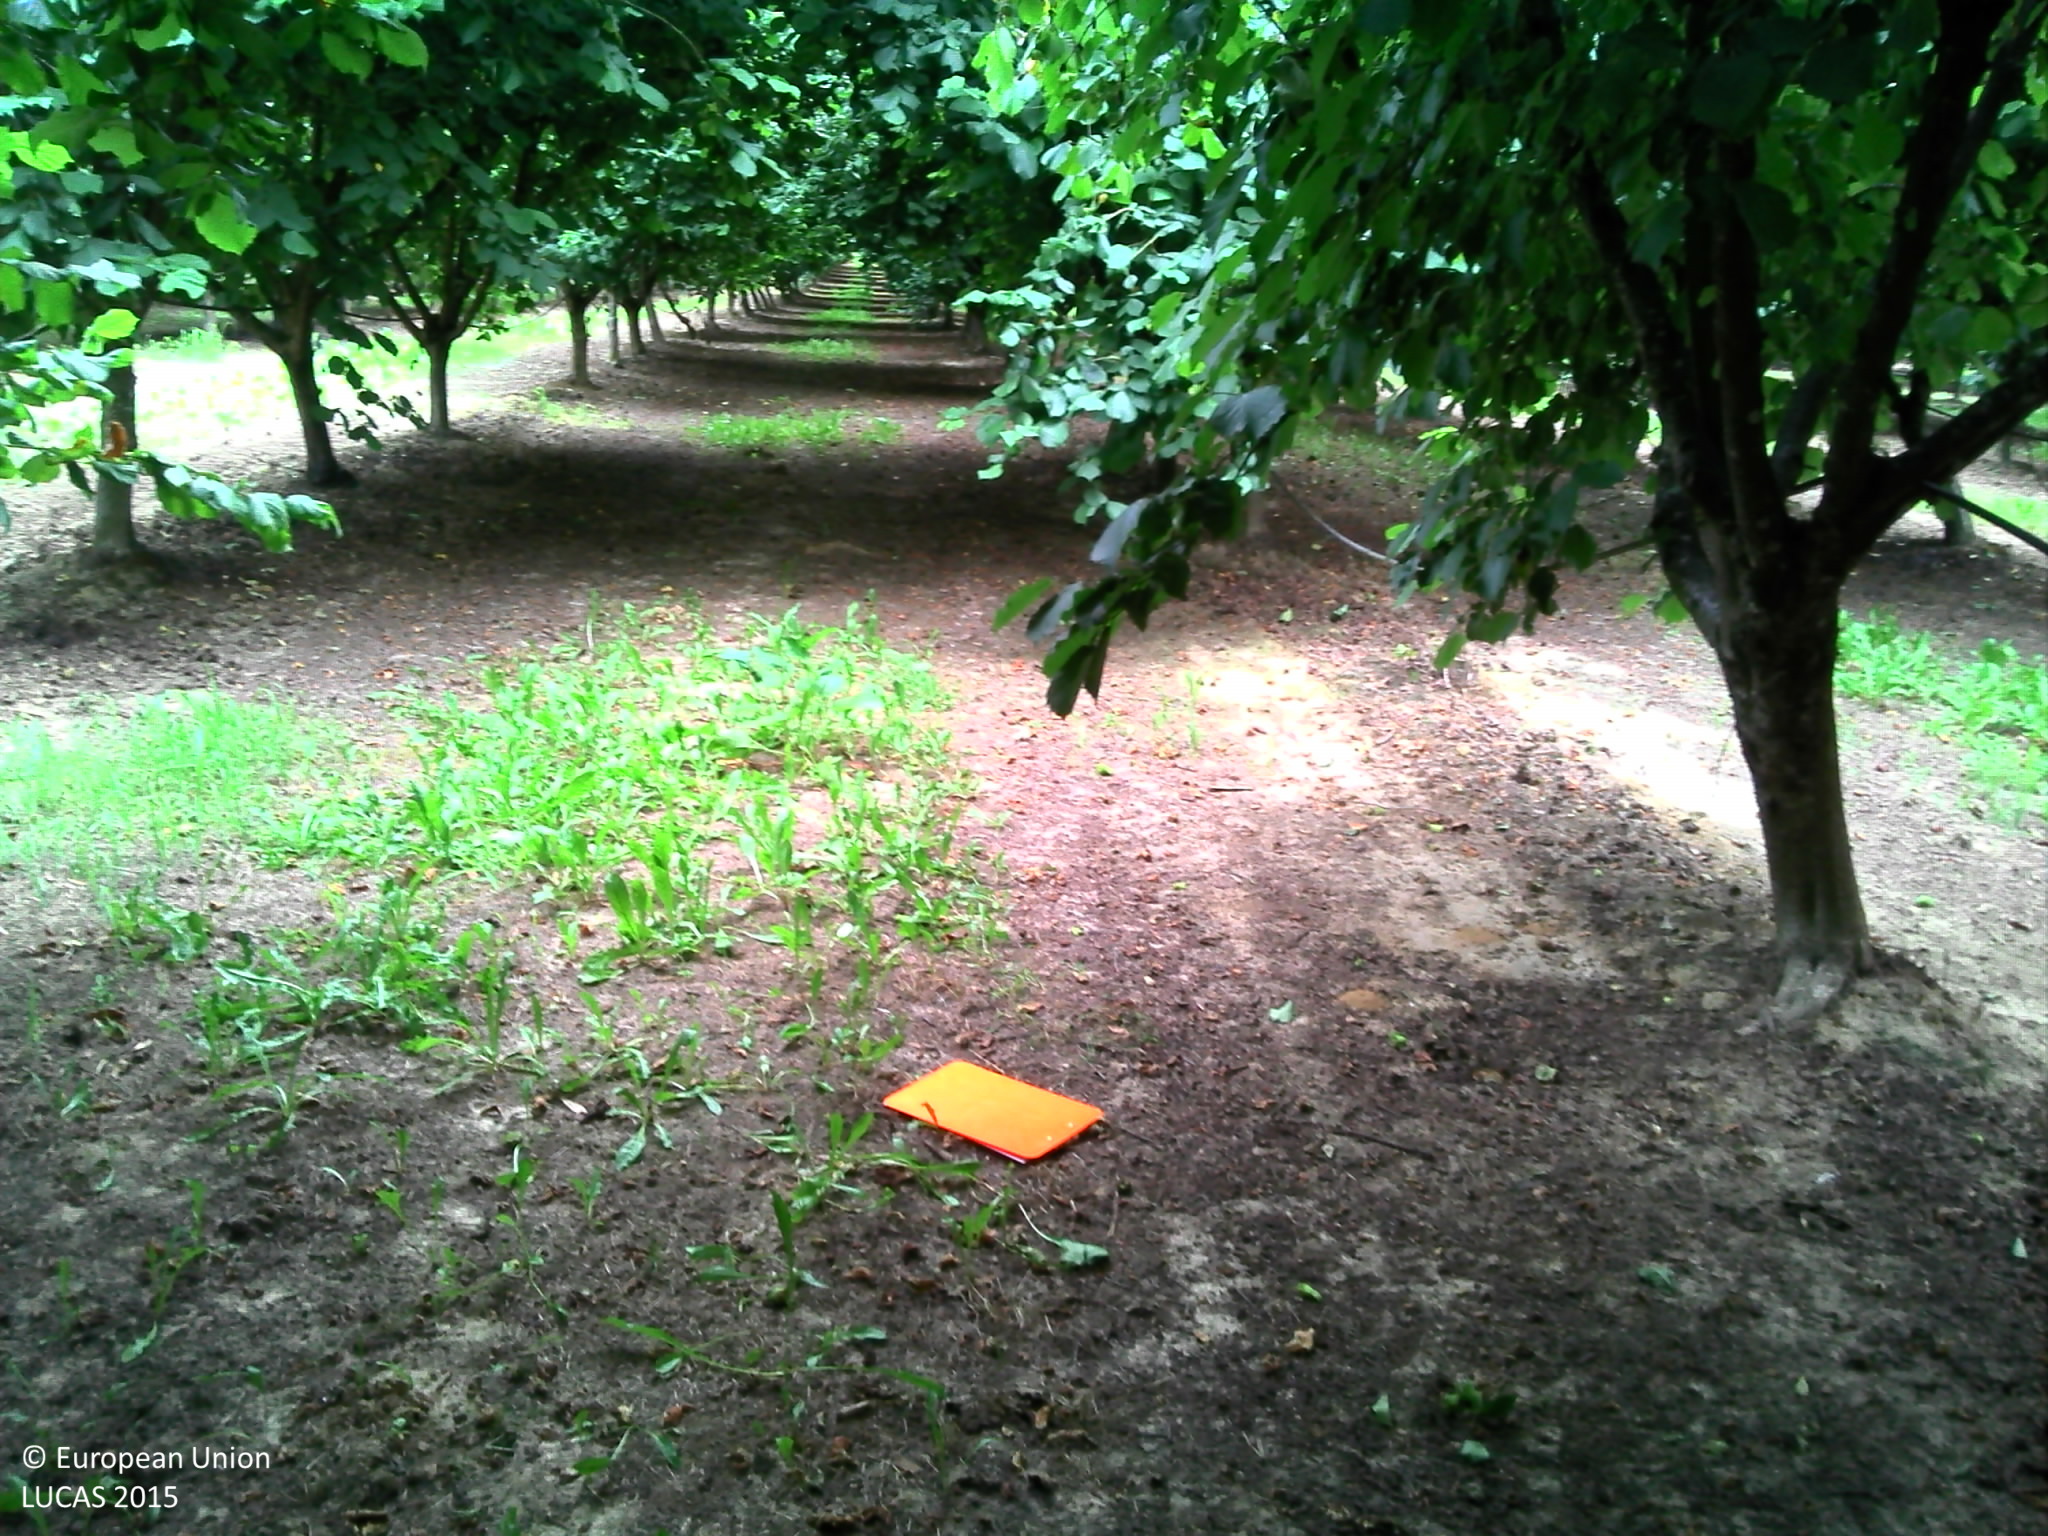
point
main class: Cropland
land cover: Nuts trees
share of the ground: > 75 %
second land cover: Spontaneously vegetated surfaces
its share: < 10 %
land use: Agriculture (excluding fallow land and kitchen gardens)
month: July
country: FR
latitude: 44.4699
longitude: 0.8306
